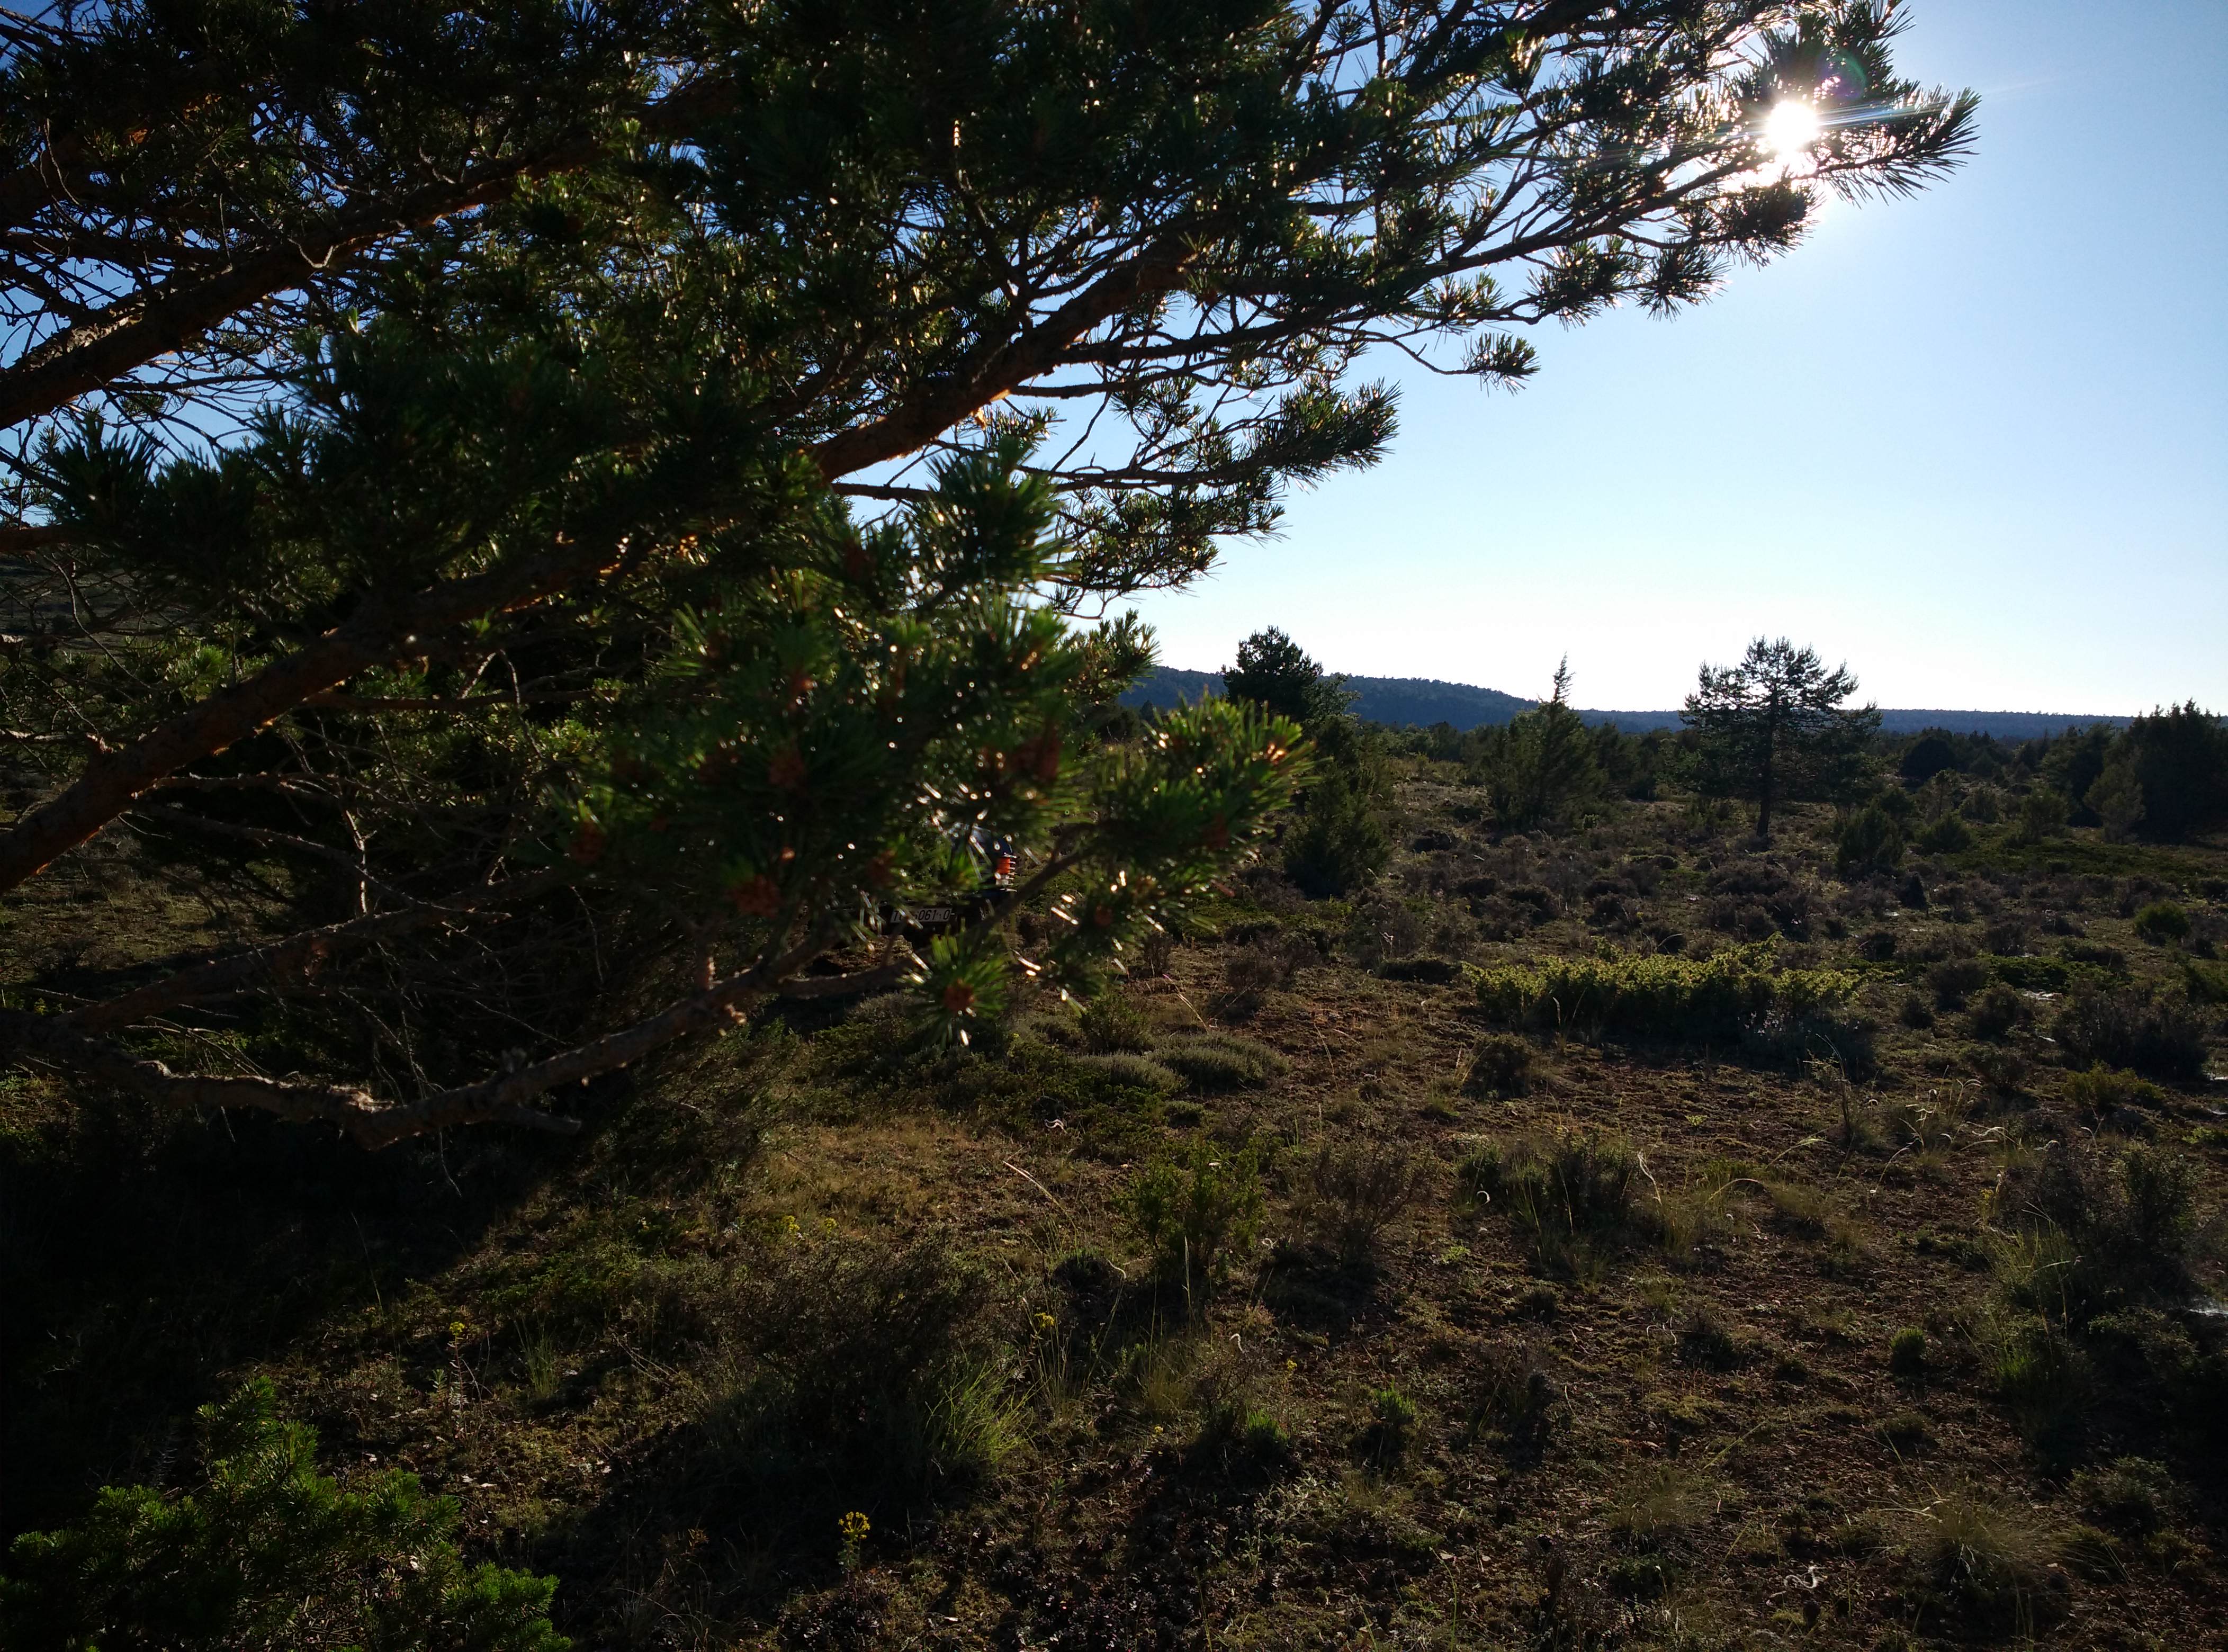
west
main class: Shrubland
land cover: Shrubland with sparse tree cover
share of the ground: 50 - 75 %
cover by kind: shrubs 50 %, unconsolidated bare surface 40 %, coniferous forest trees 5 %, herbaceous plants 5 %
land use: Semi-natural and natural areas not in use
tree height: > 5 m
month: June
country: ES
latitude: 40.6320
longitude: -1.7828
